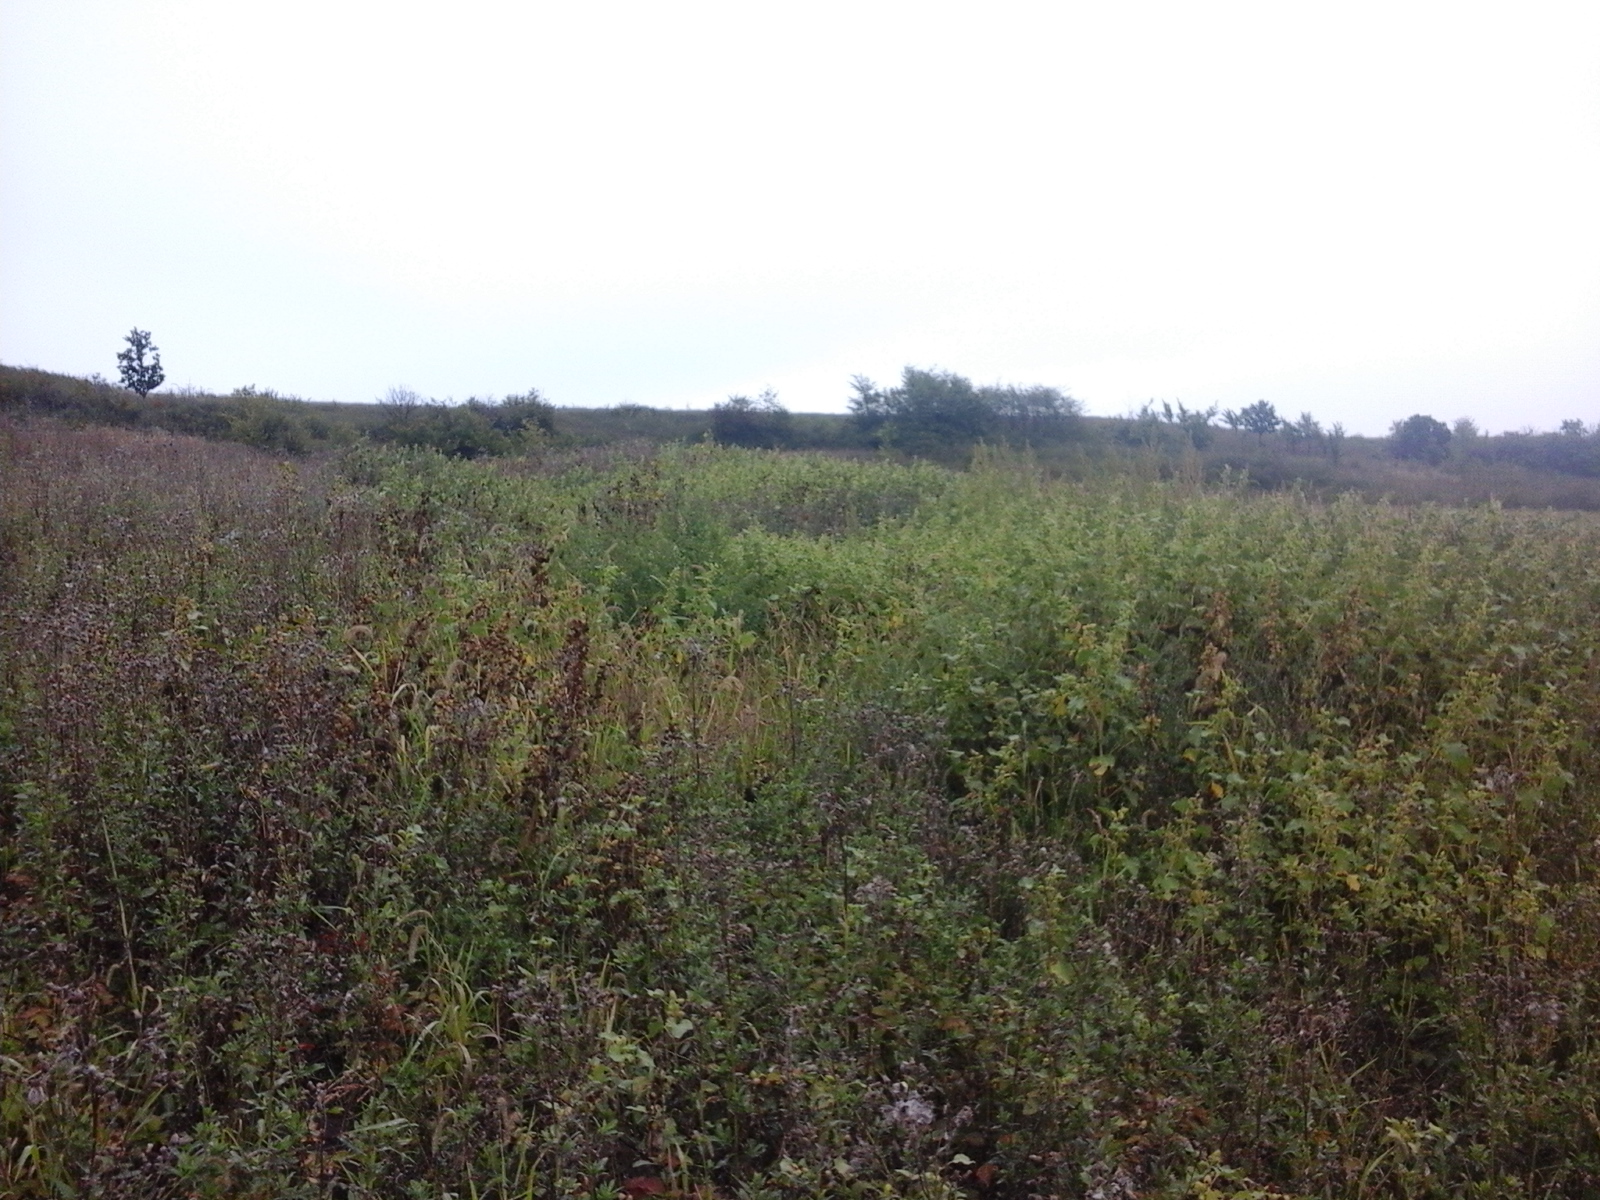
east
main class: Grassland
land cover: Spontaneously vegetated surfaces
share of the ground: > 75 %
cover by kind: herbaceous plants 100 %
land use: Fallow land
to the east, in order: Spontaneously vegetated surfaces; Shrubland with sparse tree cover; Spontaneously vegetated surfaces
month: September
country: RO
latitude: 47.3021
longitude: 22.5551
